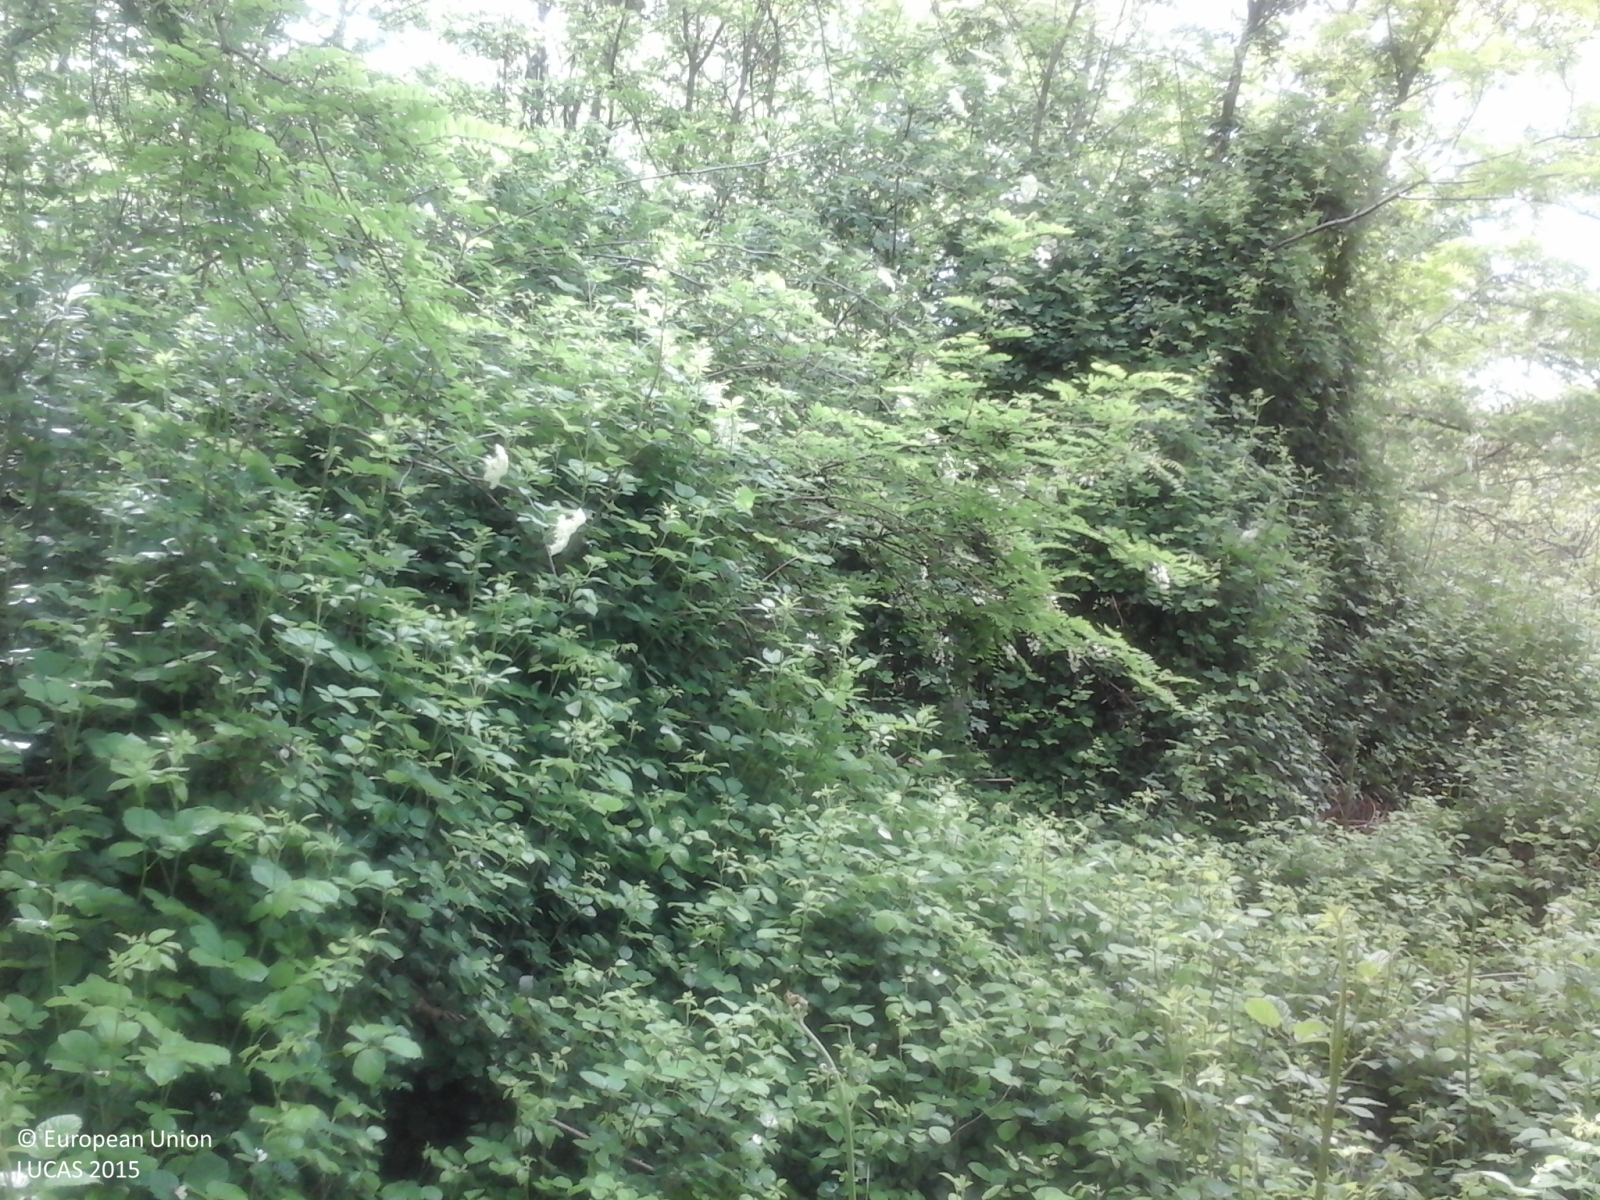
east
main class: Woodland
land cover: Broadleaved woodland
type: thermophilous deciduous forest
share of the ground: > 75 %
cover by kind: broadleaved forest trees 100 %
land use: Forestry
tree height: > 5 m
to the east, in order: Broadleaved woodland; Electric lines; Broadleaved woodland
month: May
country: IT
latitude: 45.7457
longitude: 8.4728
